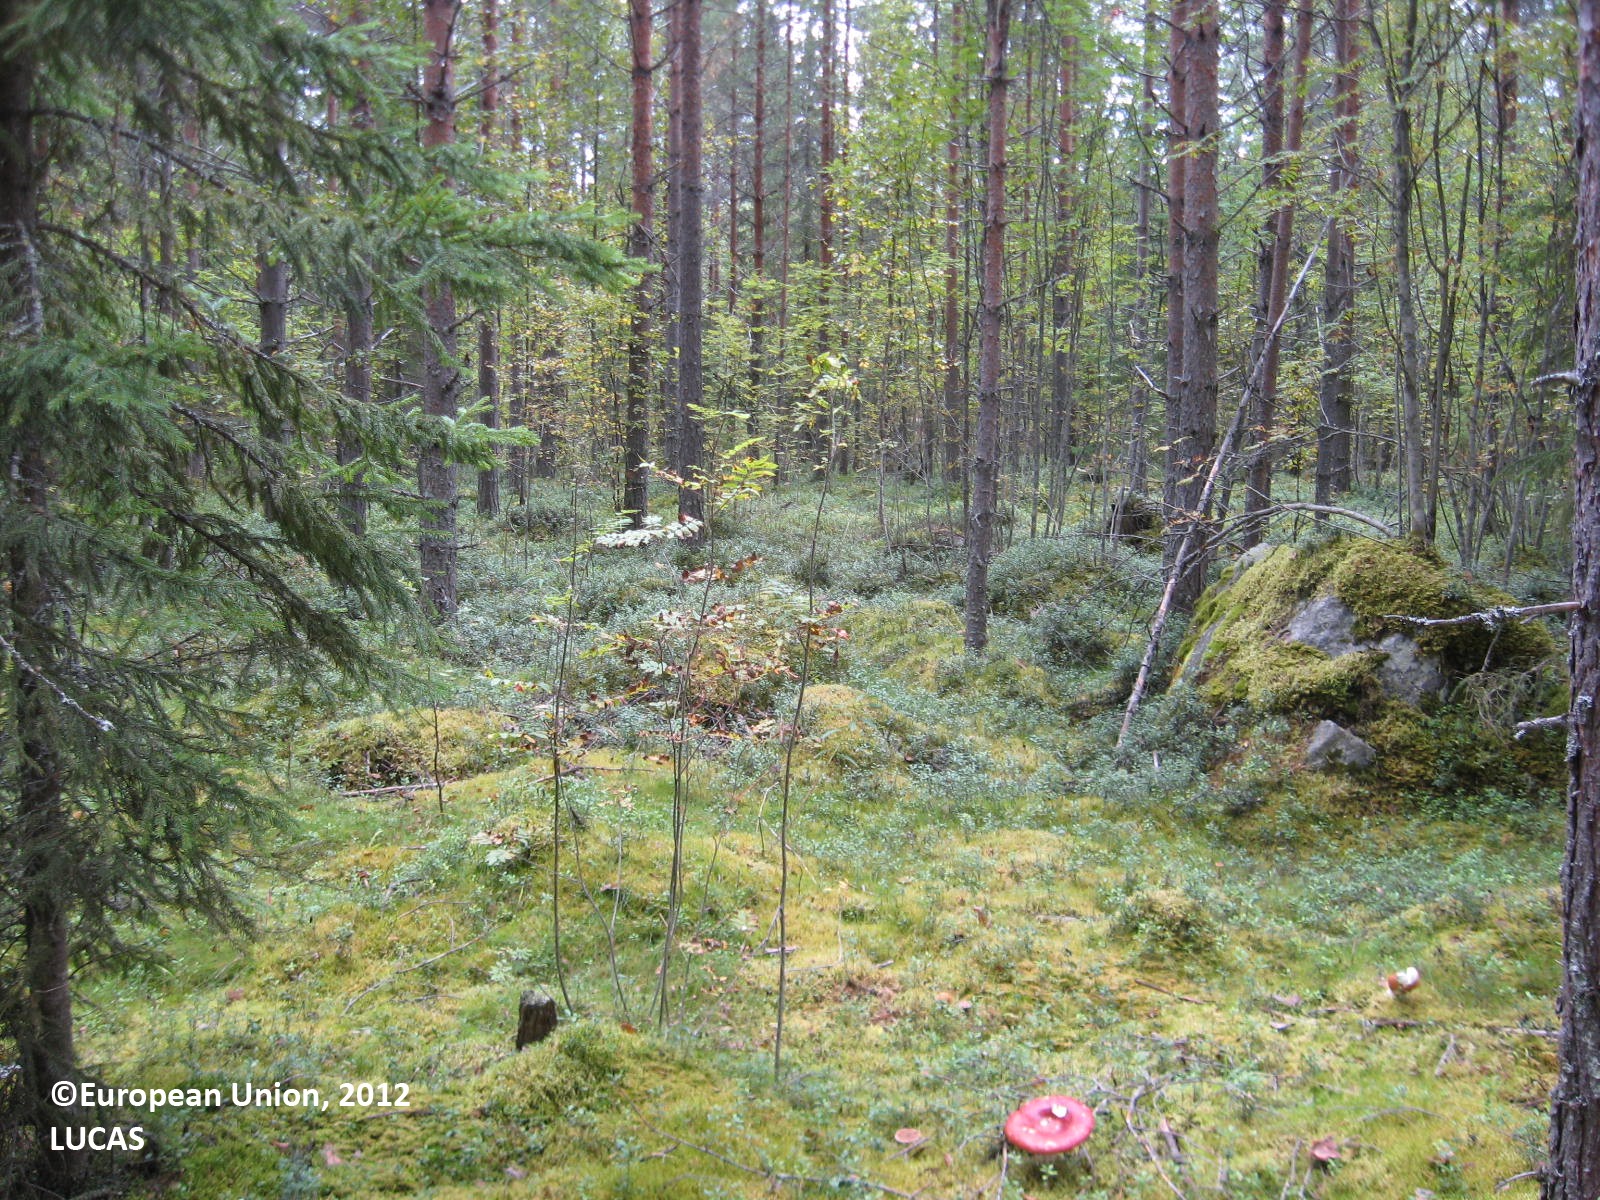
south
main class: Woodland
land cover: Pine dominated coniferous woodland
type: boreal forest
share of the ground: > 75 %
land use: Forestry
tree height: > 5 m
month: August
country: FI
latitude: 63.6138
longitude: 29.2337
